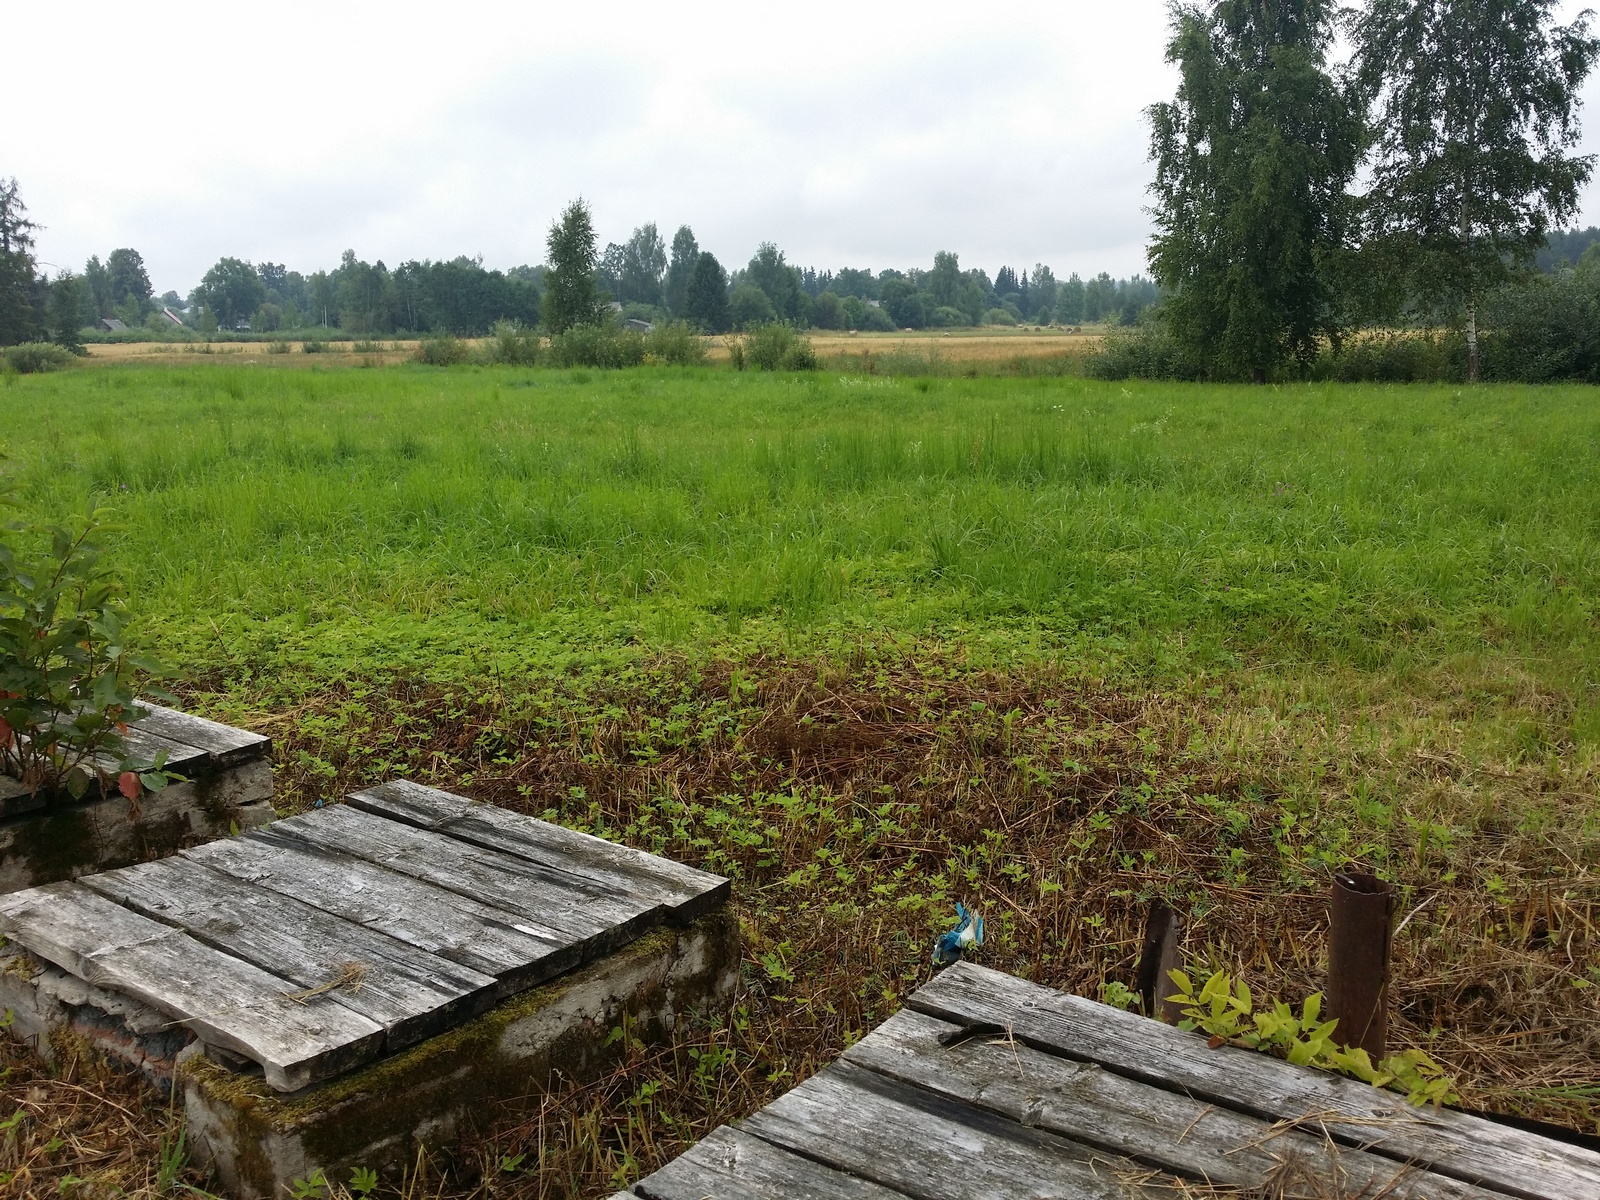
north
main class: Grassland
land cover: Grassland without tree/shrub cover
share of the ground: > 75 %
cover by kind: herbaceous plants 90 %, unconsolidated bare surface 10 %
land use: Agriculture (excluding fallow land and kitchen gardens)
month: August
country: LV
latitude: 57.5316
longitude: 26.6997
